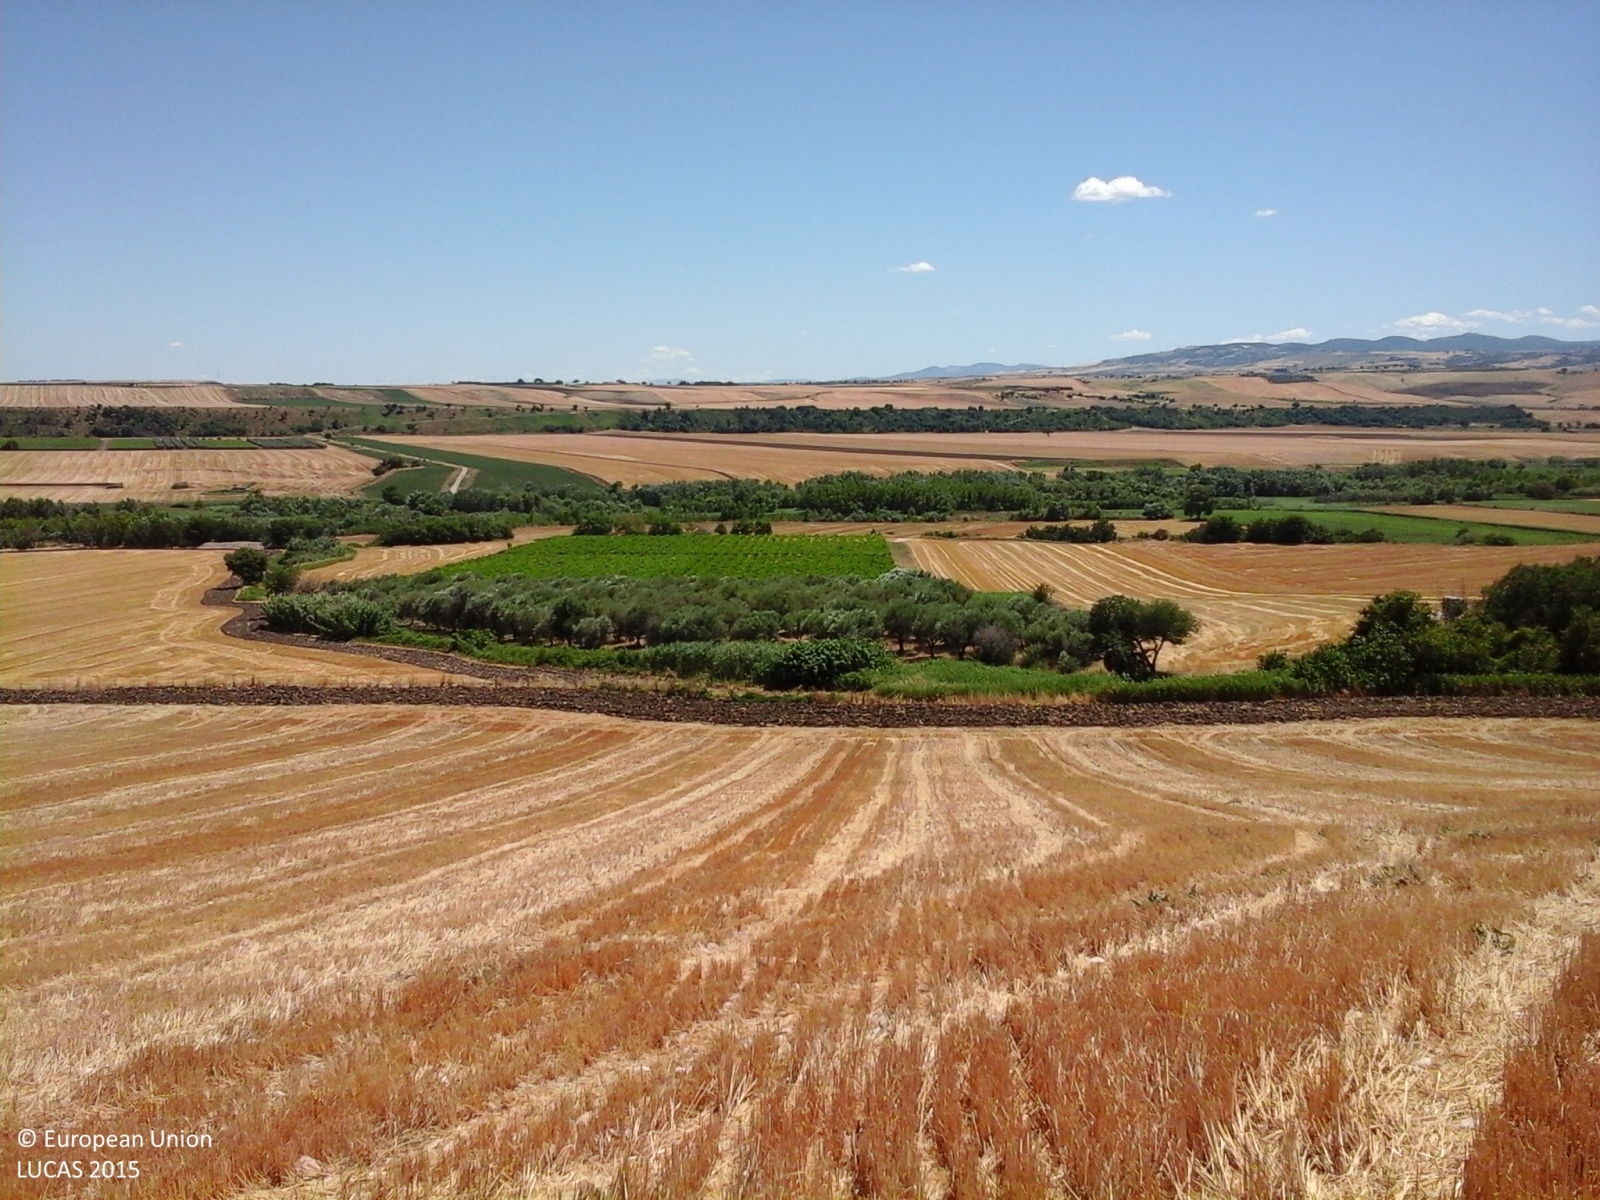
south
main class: Cropland
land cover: Durum wheat
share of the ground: > 75 %
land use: Agriculture (excluding fallow land and kitchen gardens)
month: June
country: IT
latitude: 41.7090
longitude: 15.1393
